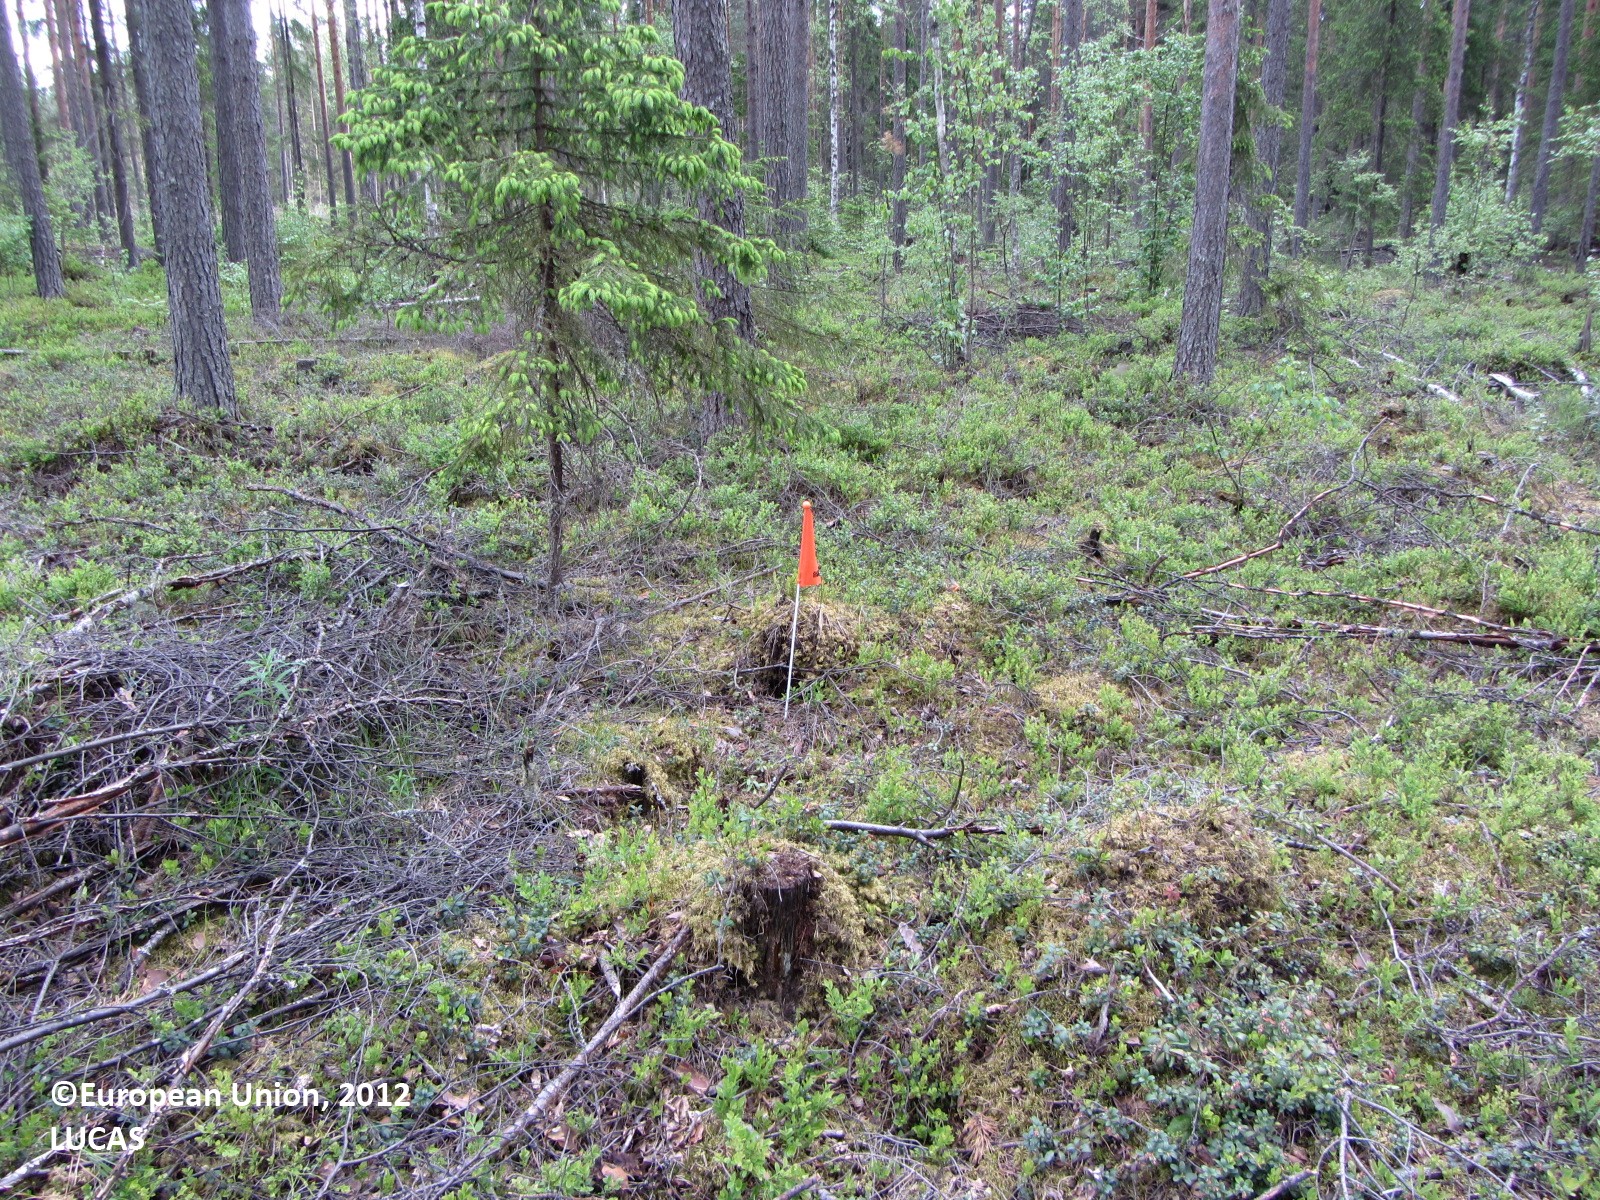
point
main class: Woodland
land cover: Pine dominated mixed woodland
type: boreal forest
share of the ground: 50 - 75 %
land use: Forestry
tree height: > 5 m
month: June
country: FI
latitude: 61.9361
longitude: 25.1033
